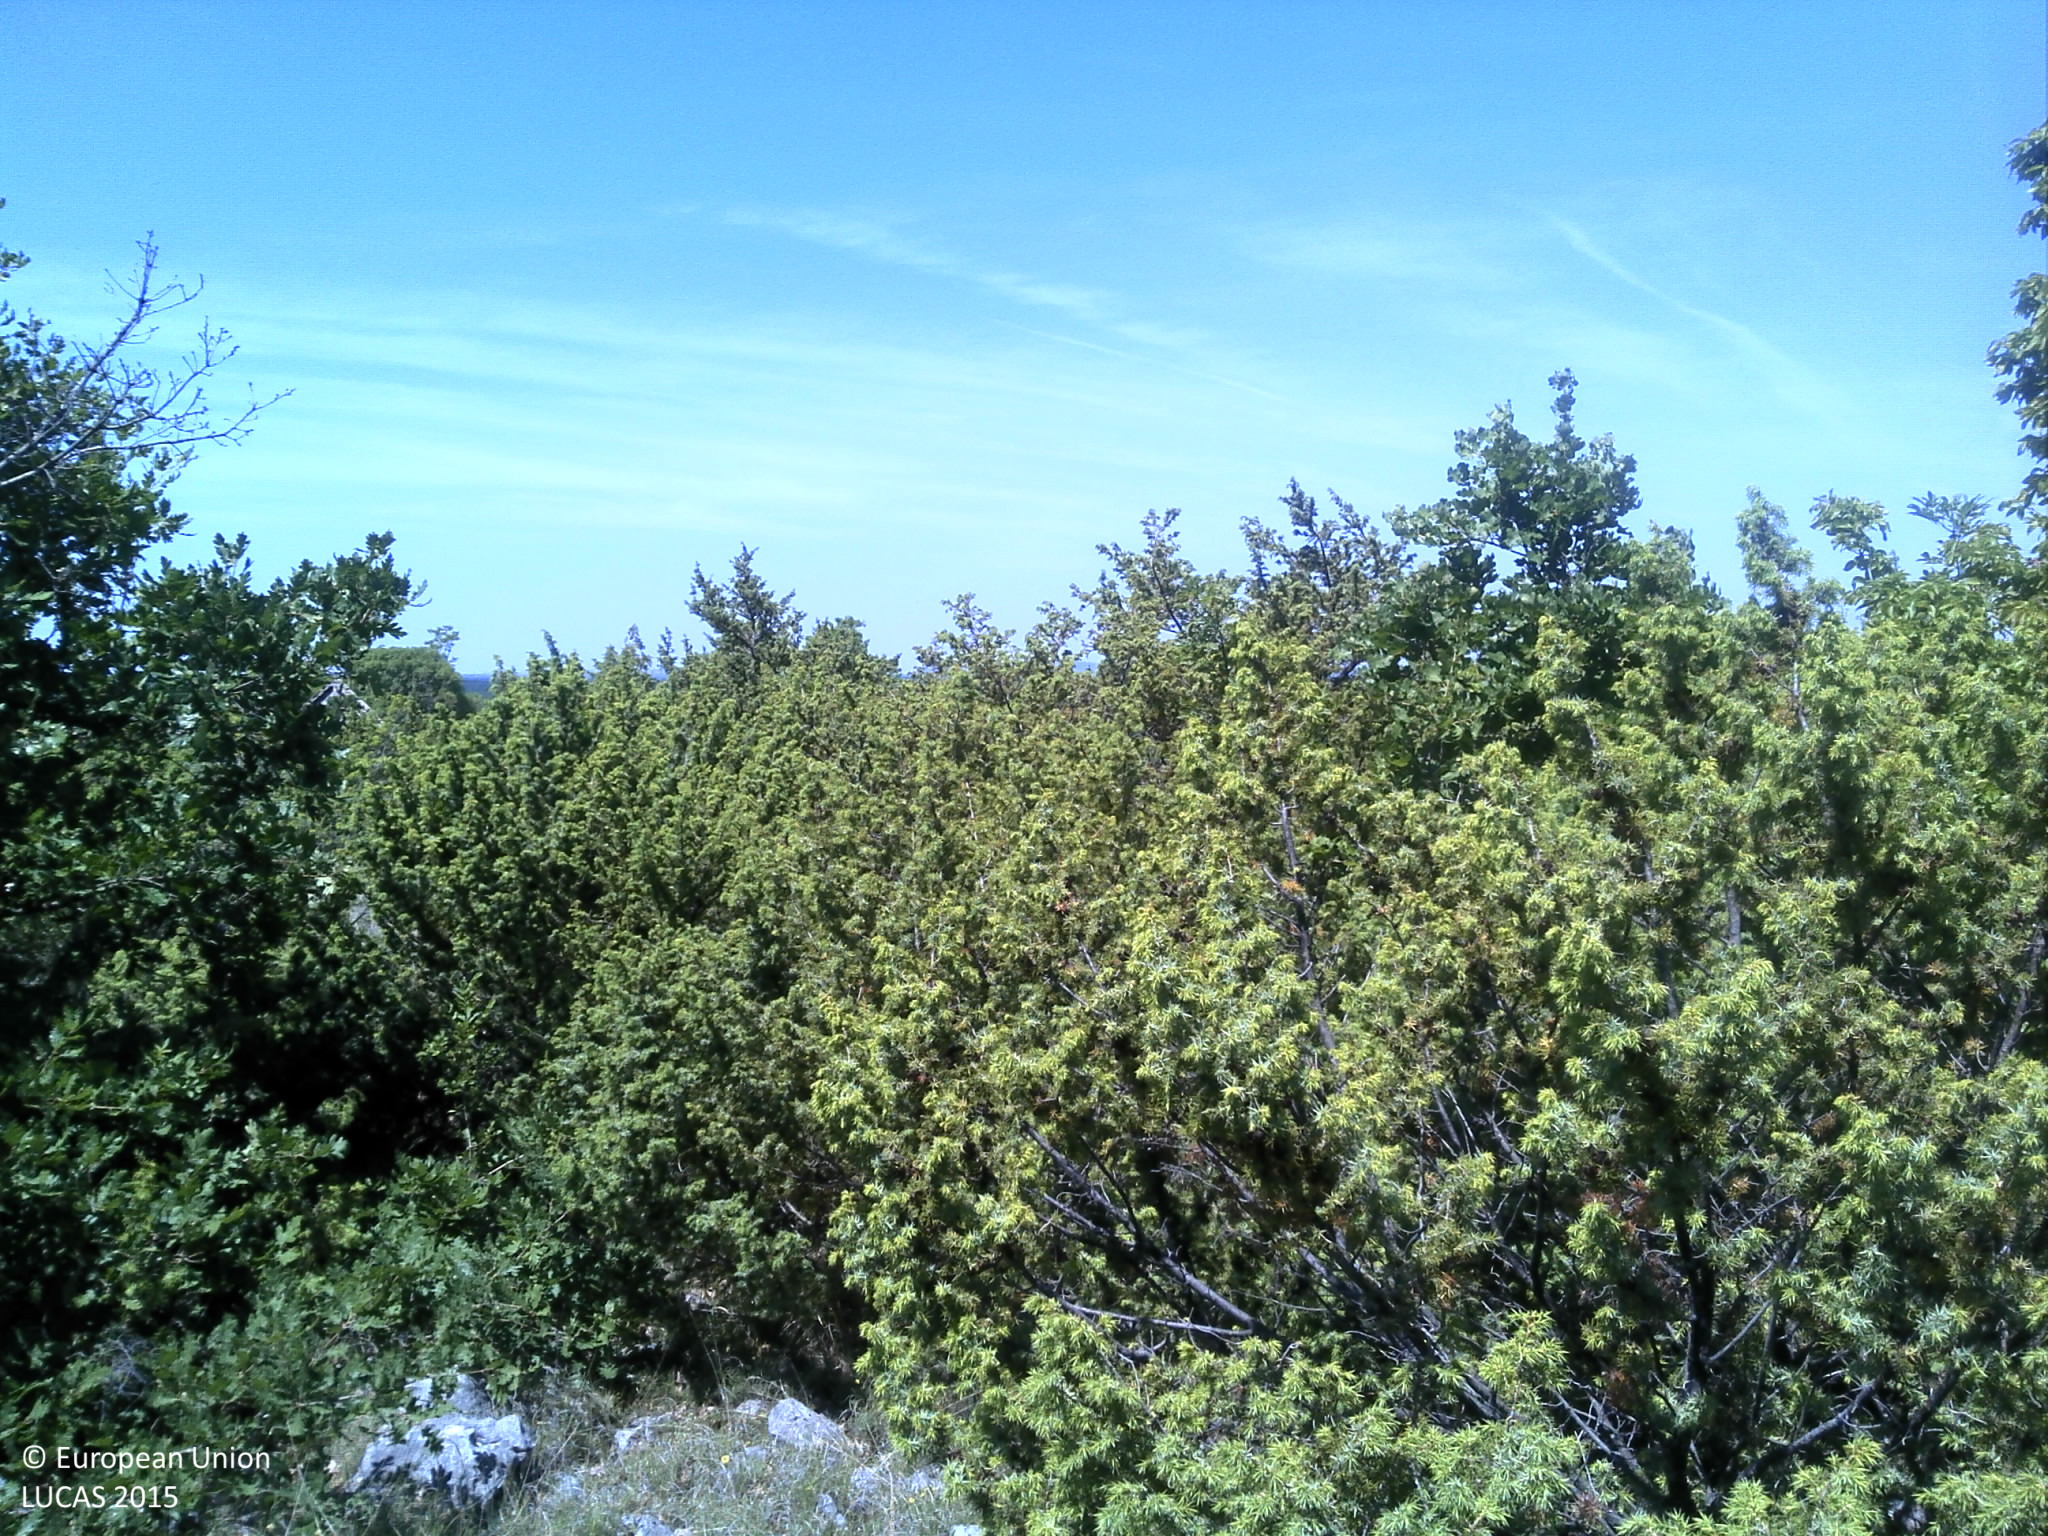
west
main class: Shrubland
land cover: Shrubland with sparse tree cover
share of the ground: 50 - 75 %
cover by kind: shrubs 50 %, herbaceous plants 35 %, unconsolidated bare surface 10 %, coniferous forest trees 5 %
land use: Semi-natural and natural areas not in use
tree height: < 5 m
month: May
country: HR
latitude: 43.9355
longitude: 16.1086
